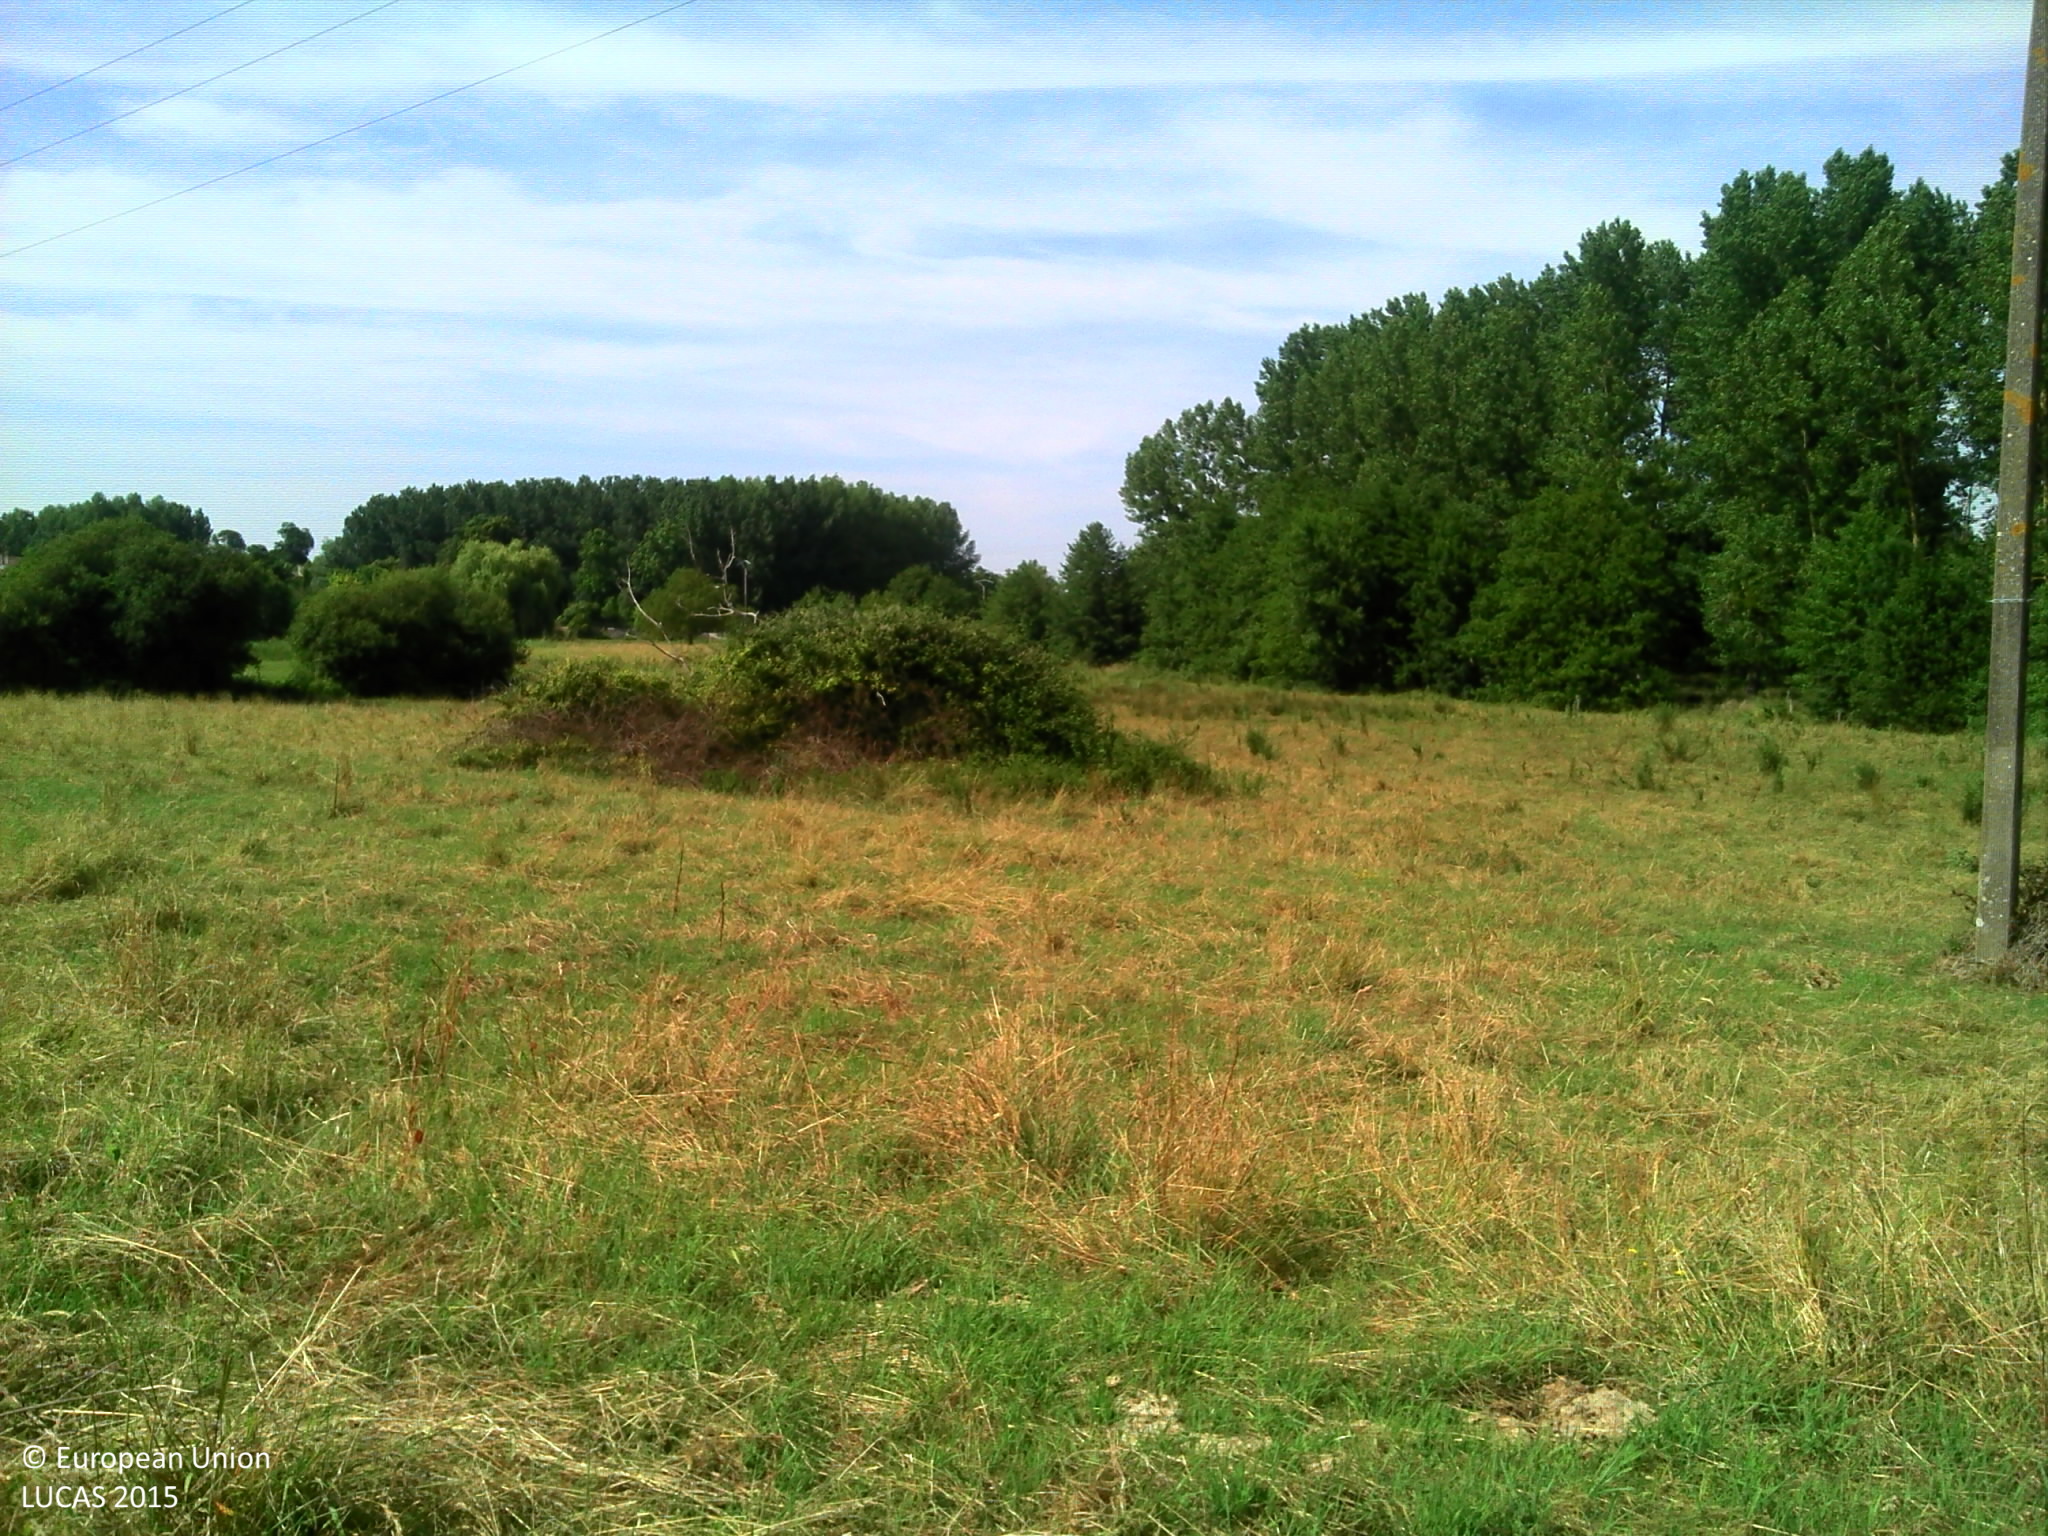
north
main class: Grassland
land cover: Grassland without tree/shrub cover
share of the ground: > 75 %
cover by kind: herbaceous plants 100 %
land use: Agriculture (excluding fallow land and kitchen gardens)
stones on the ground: < 10 %
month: June
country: FR
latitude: 45.8283
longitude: -0.9048
